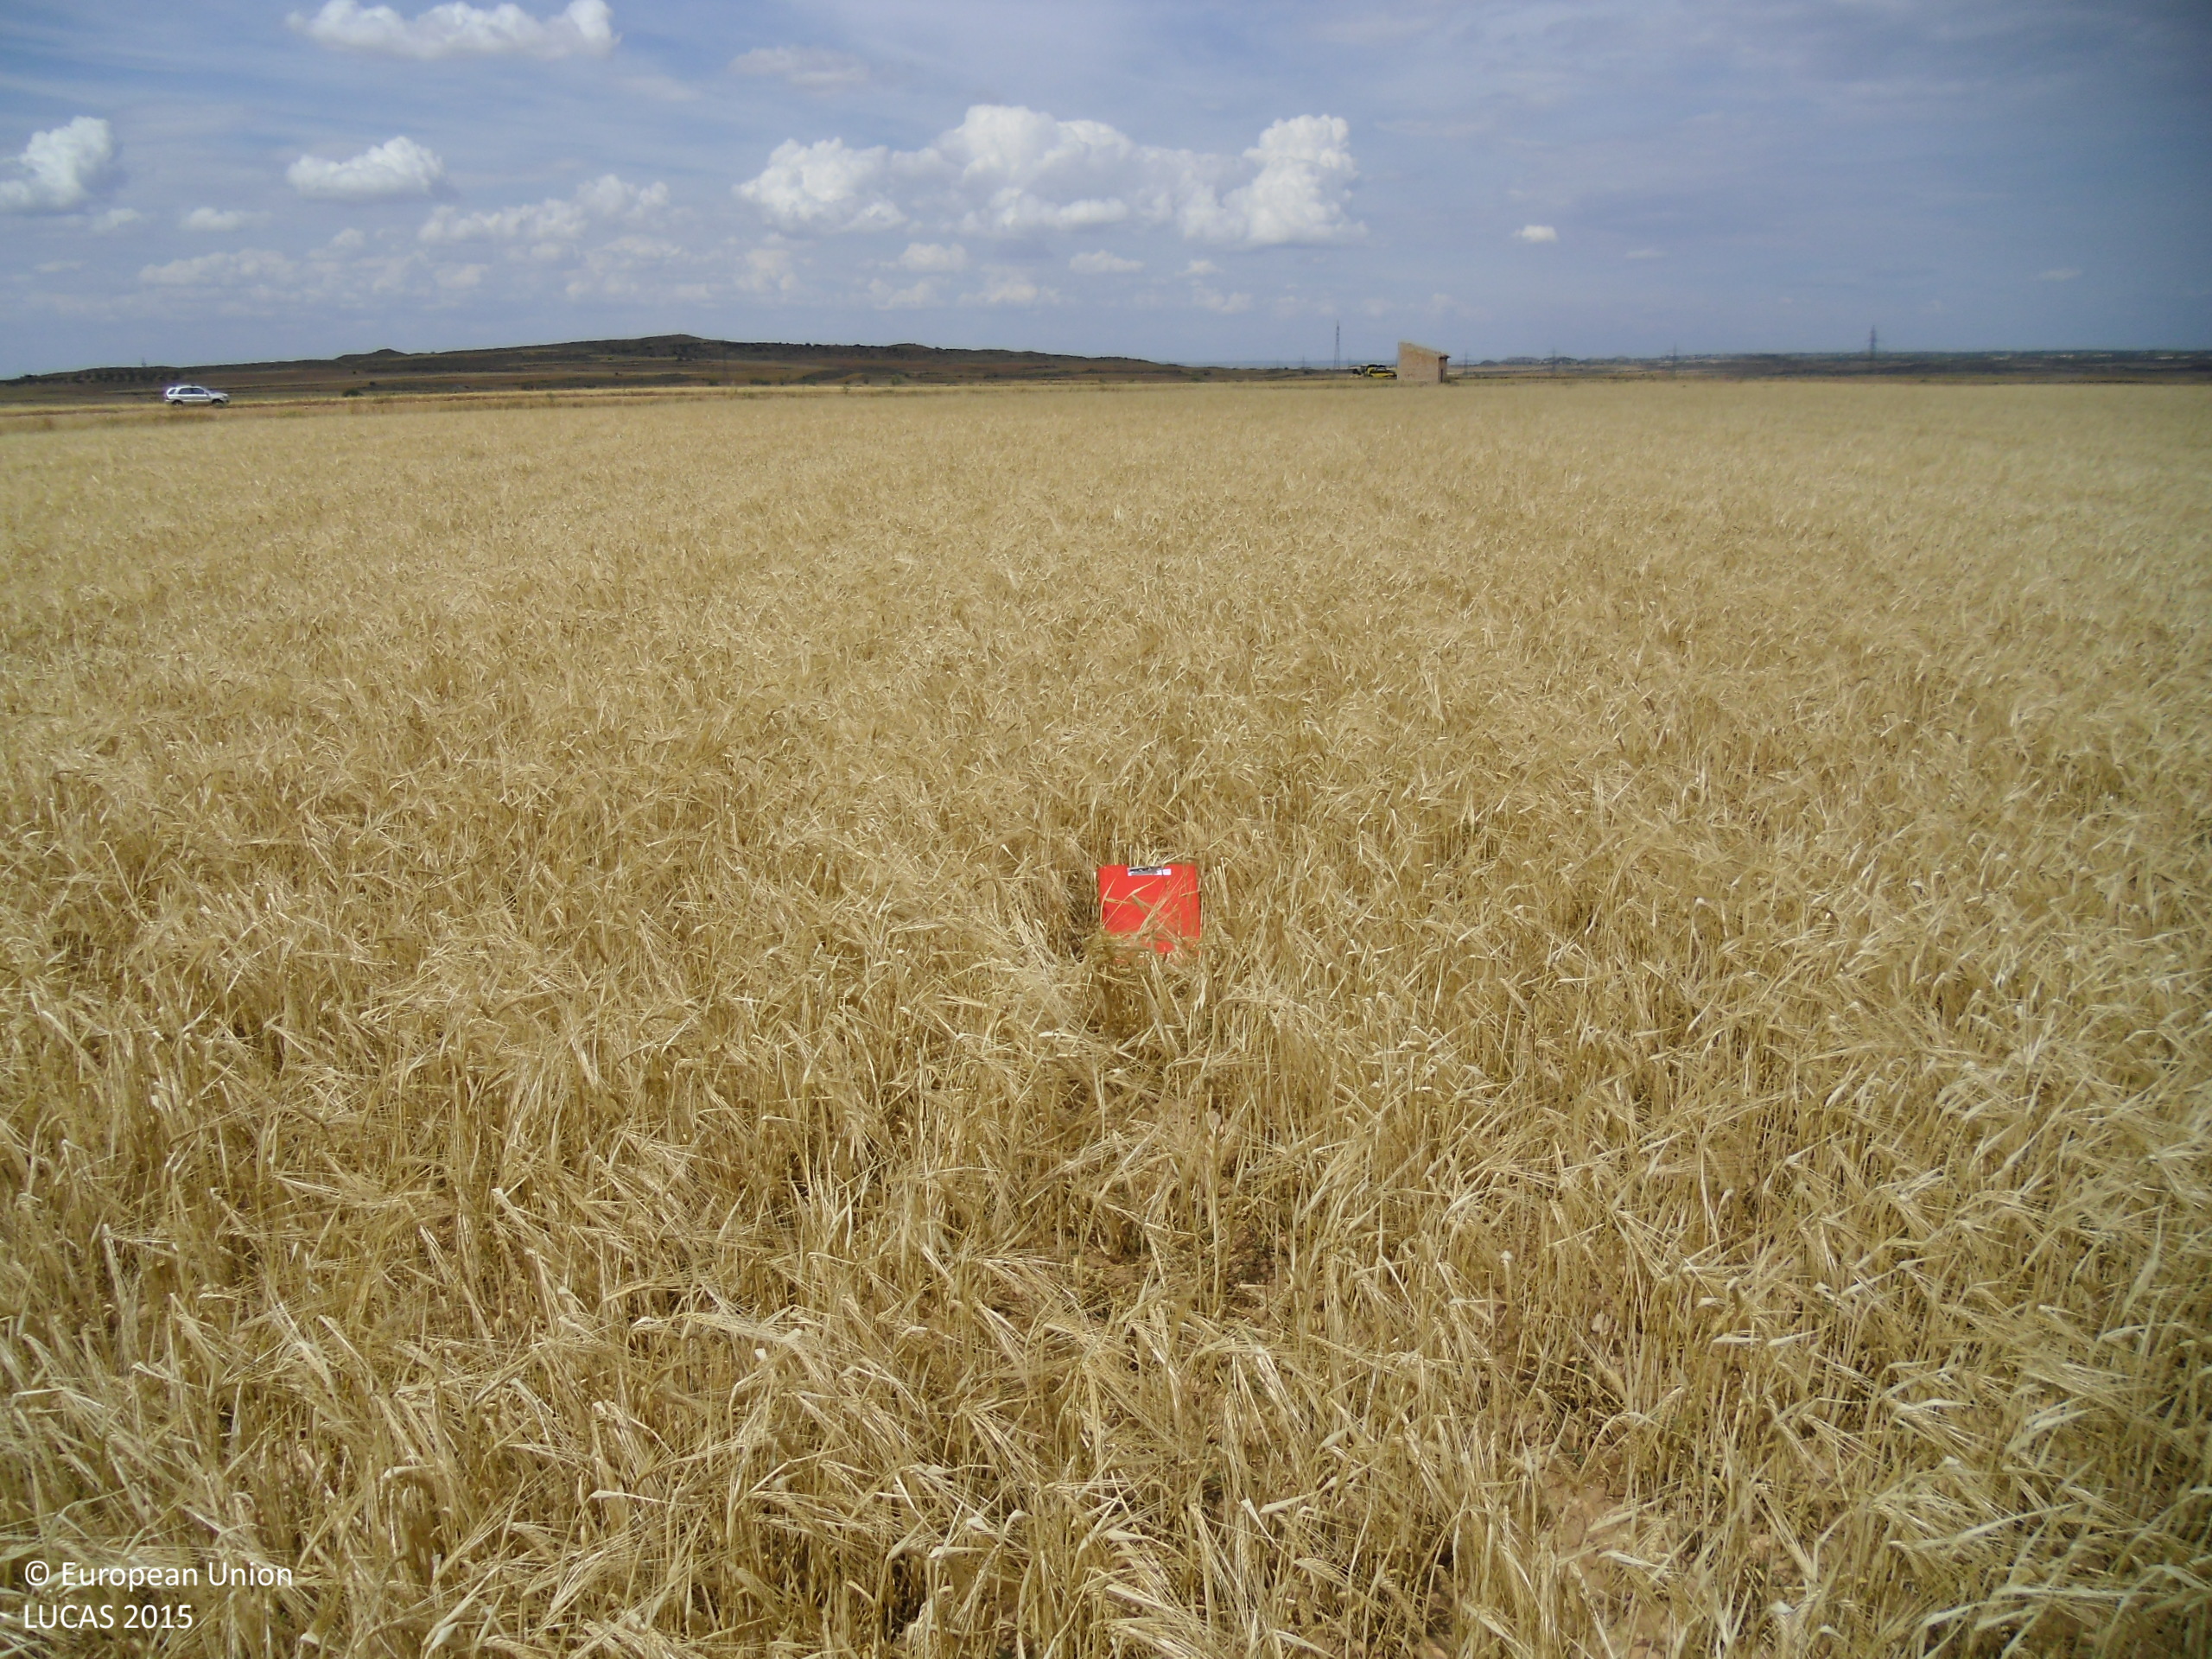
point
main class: Cropland
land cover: Rye
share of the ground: > 75 %
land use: Agriculture (excluding fallow land and kitchen gardens)
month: June
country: ES
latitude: 41.1224
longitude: -0.3397
